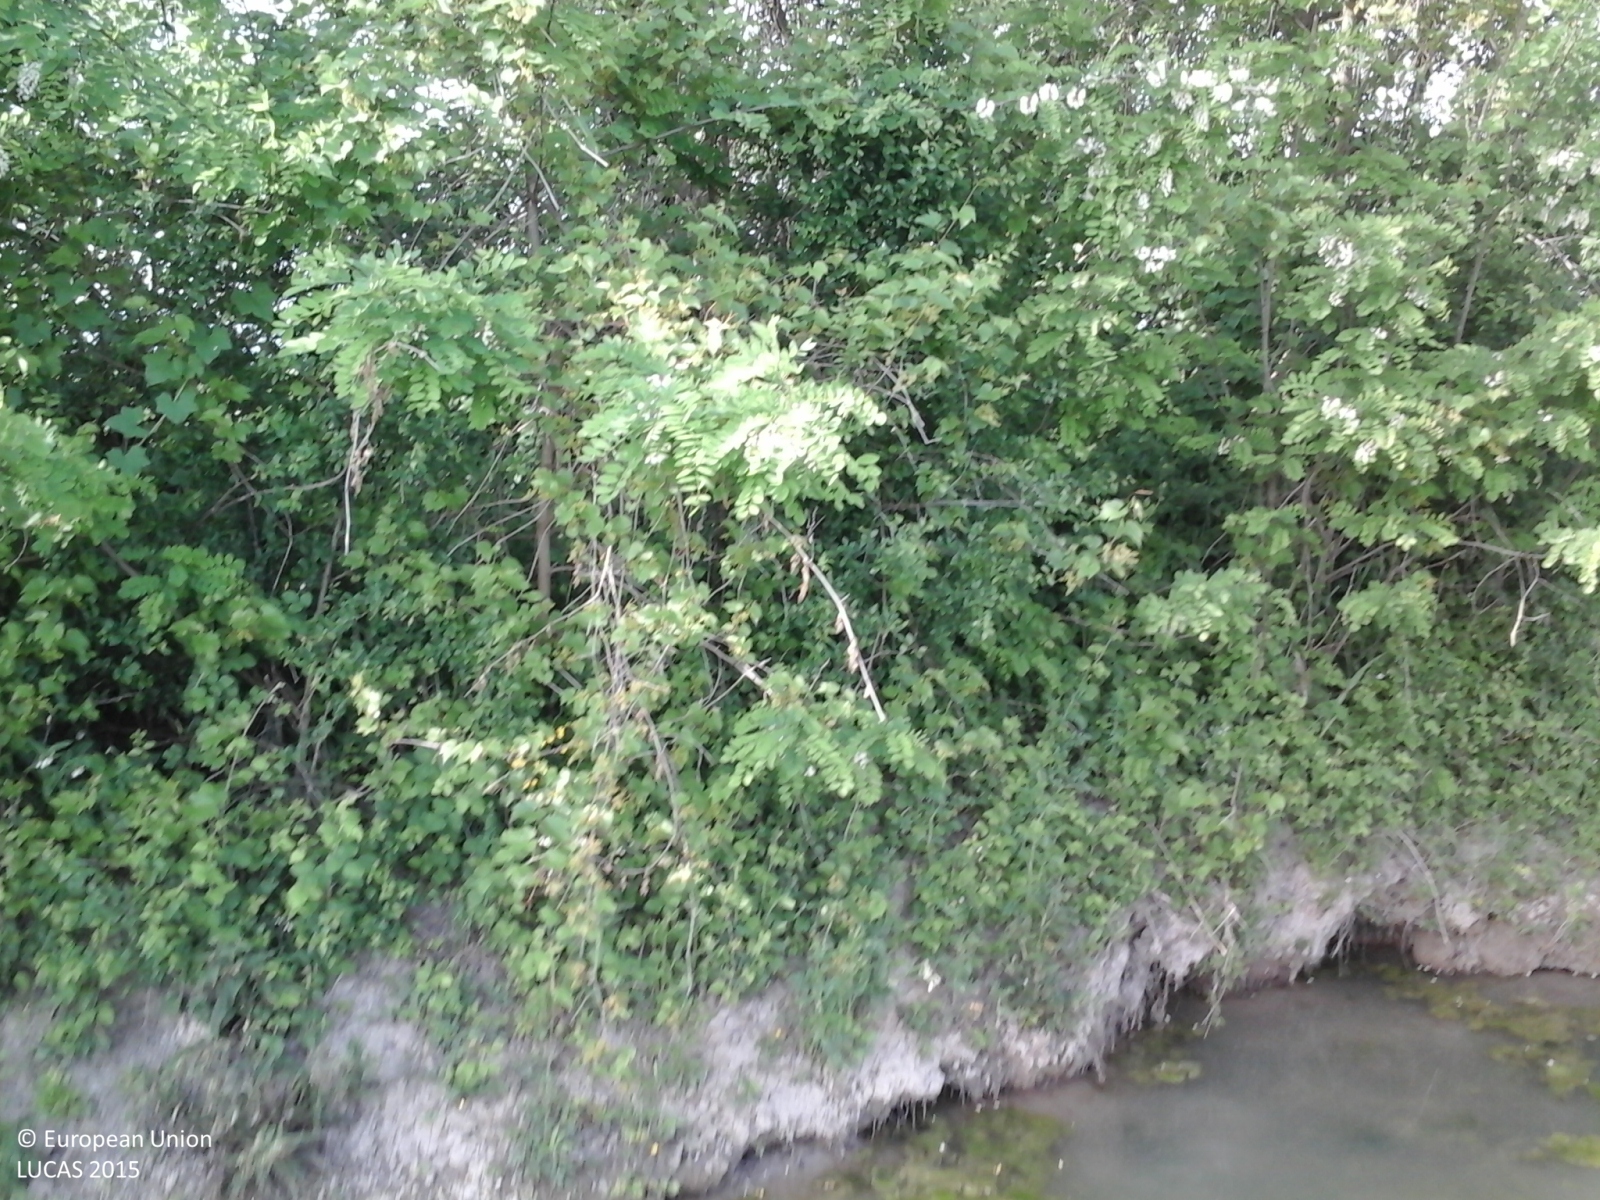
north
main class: Cropland
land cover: Common wheat
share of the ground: > 75 %
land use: Agriculture (excluding fallow land and kitchen gardens)
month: May
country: IT
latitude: 45.1664
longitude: 11.6891
